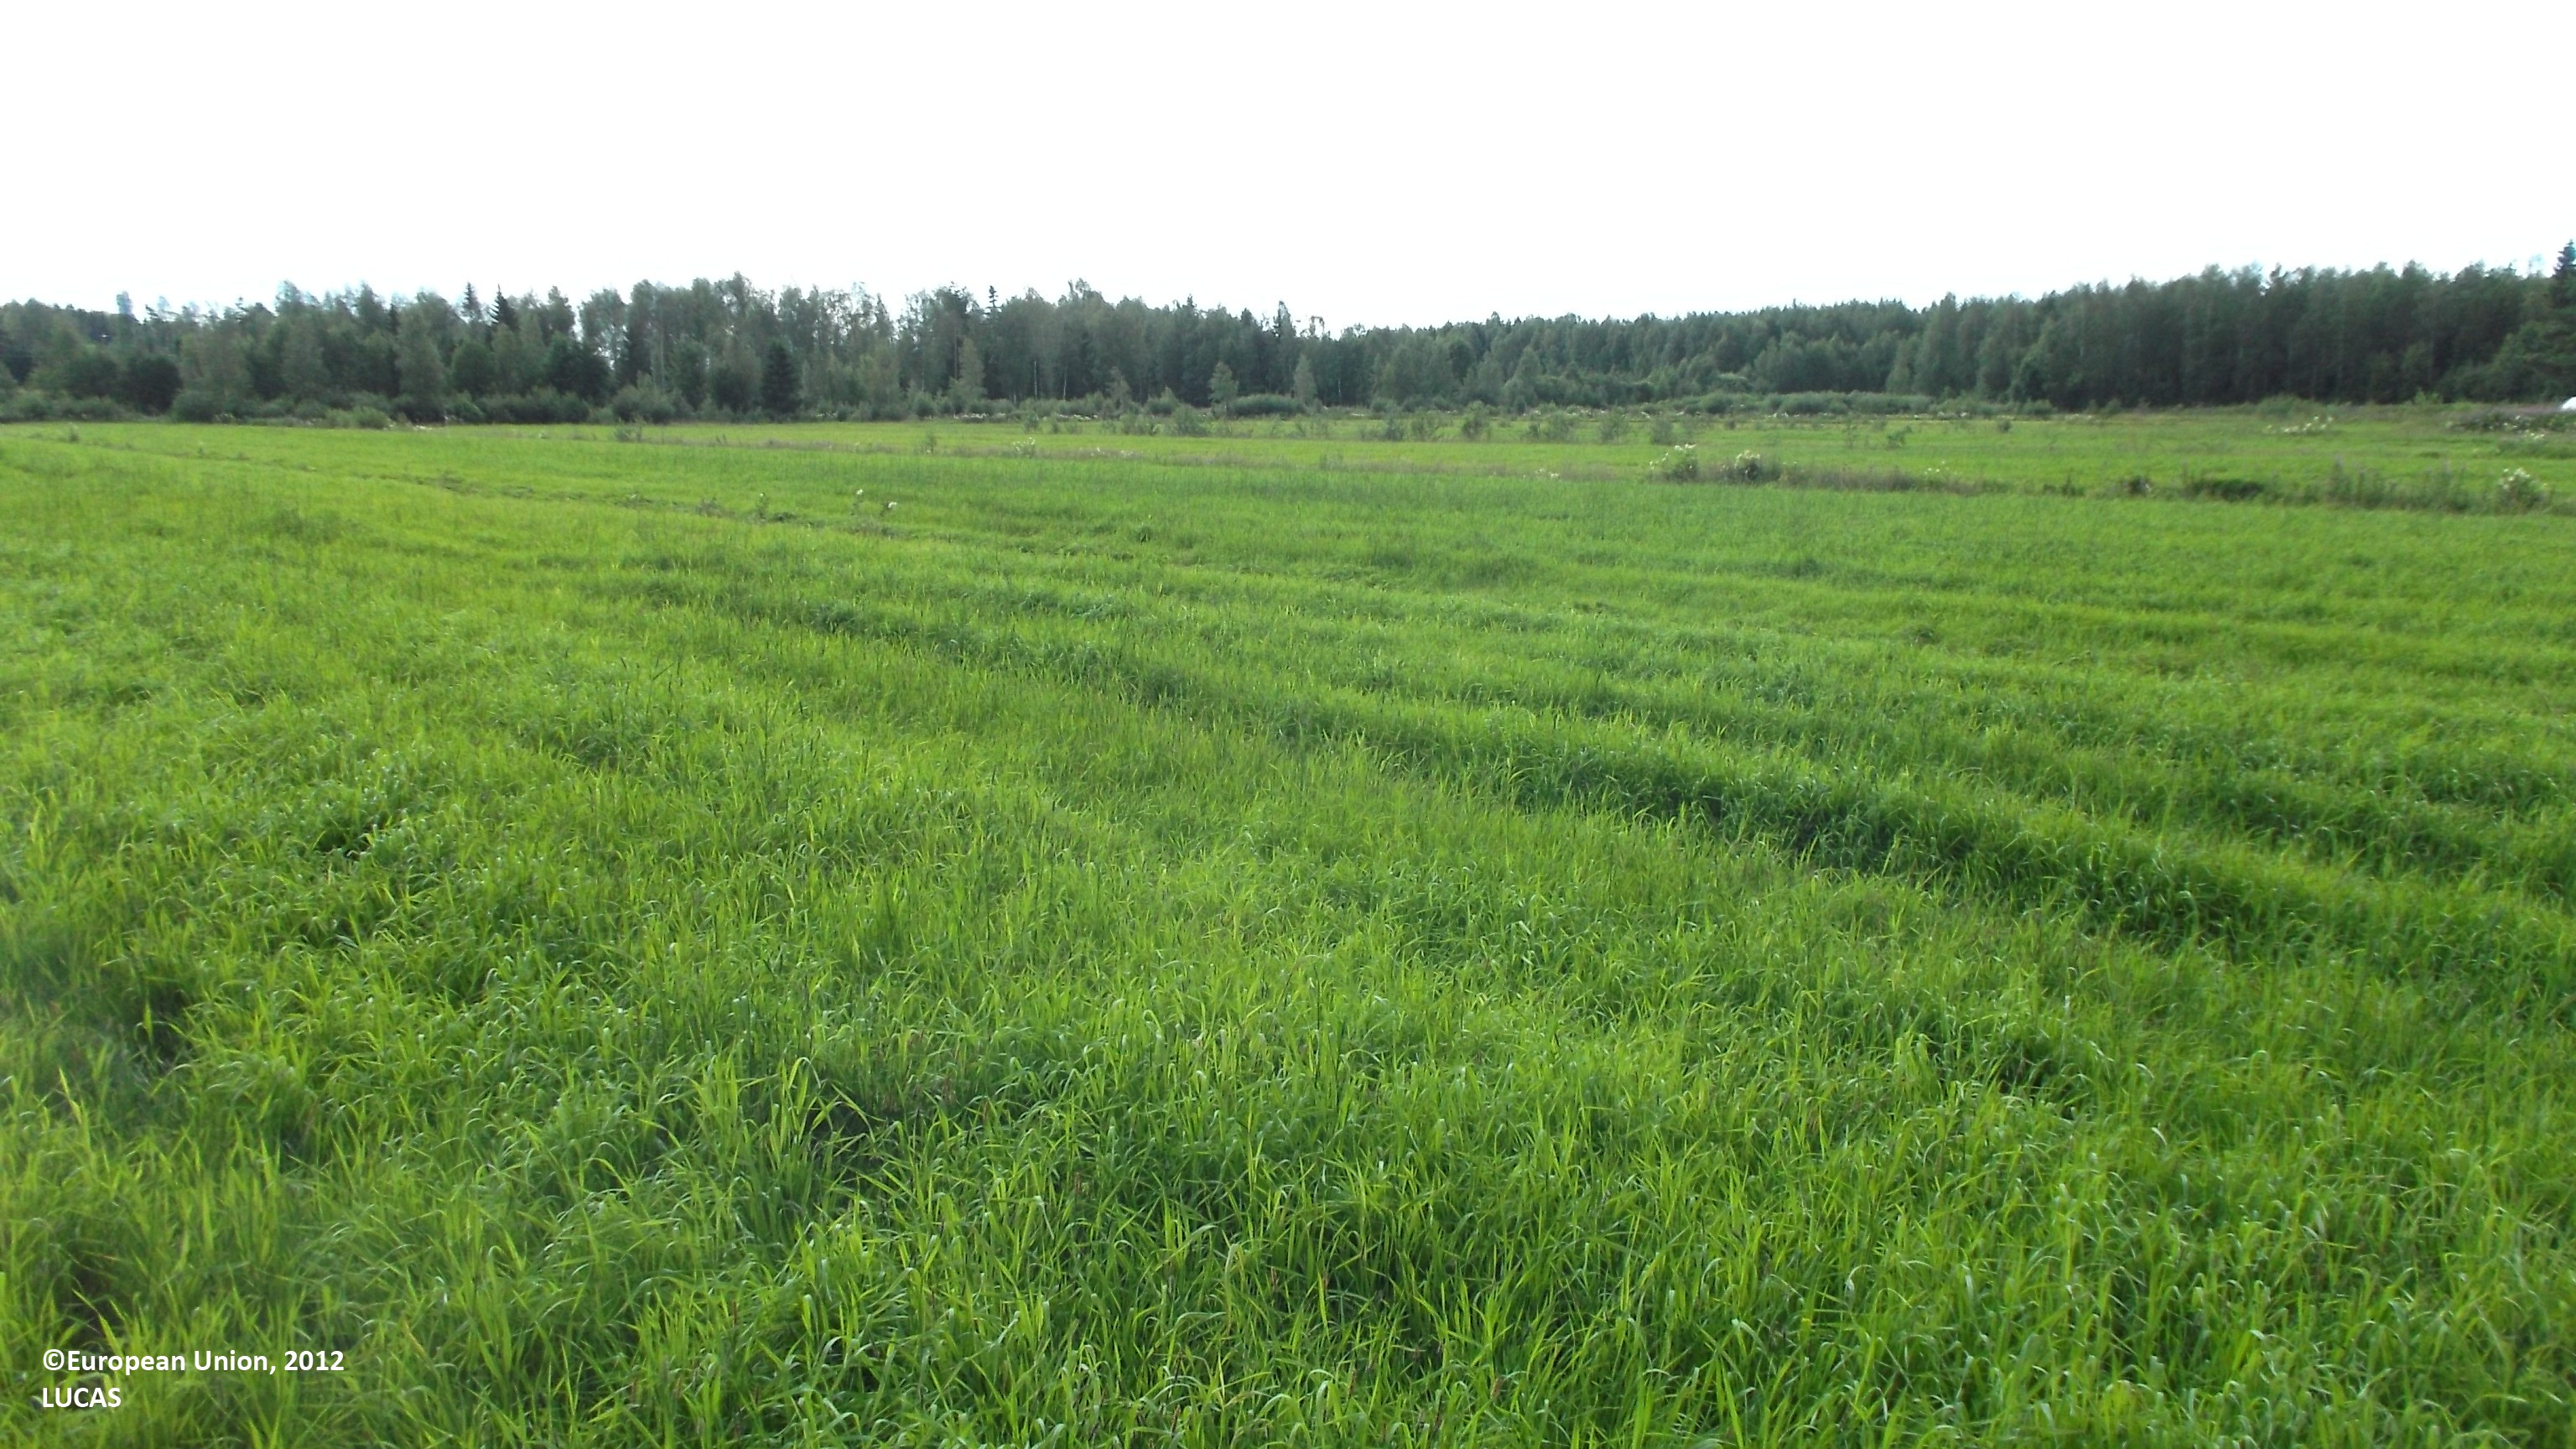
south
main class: Cropland
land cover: Temporary grasslands
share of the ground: > 75 %
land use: Agriculture (excluding fallow land and kitchen gardens)
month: July
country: FI
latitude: 63.6421
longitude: 23.1983
